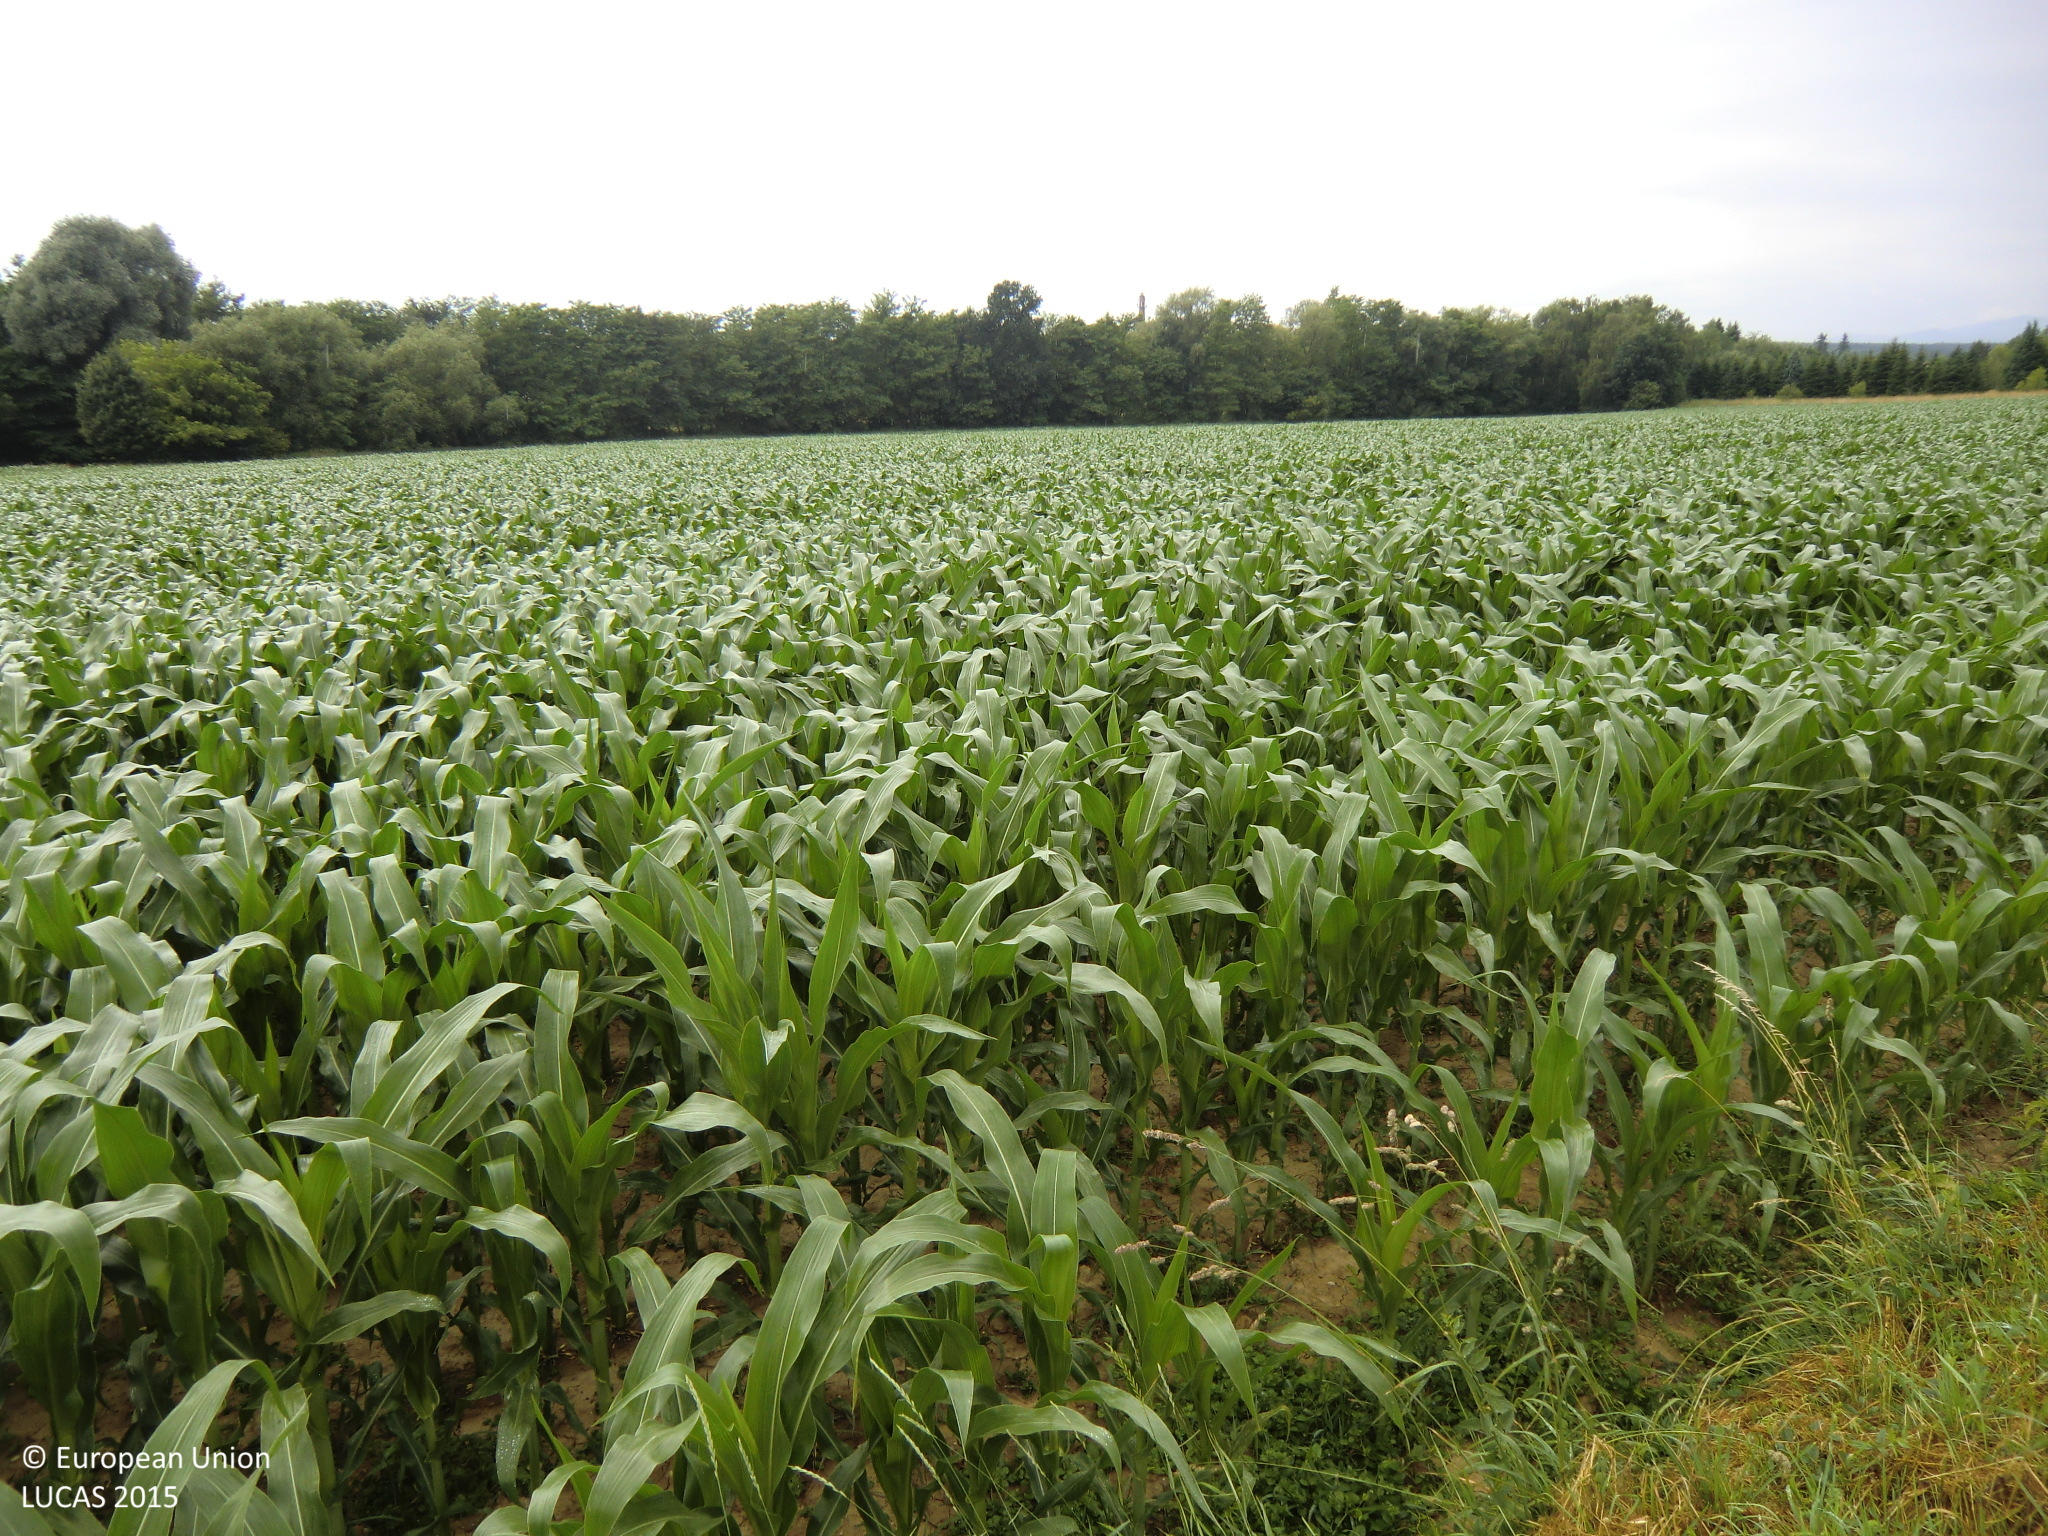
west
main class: Cropland
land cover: Maize
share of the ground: > 75 %
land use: Agriculture (excluding fallow land and kitchen gardens)
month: June
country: AT
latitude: 47.1697
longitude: 16.1100
